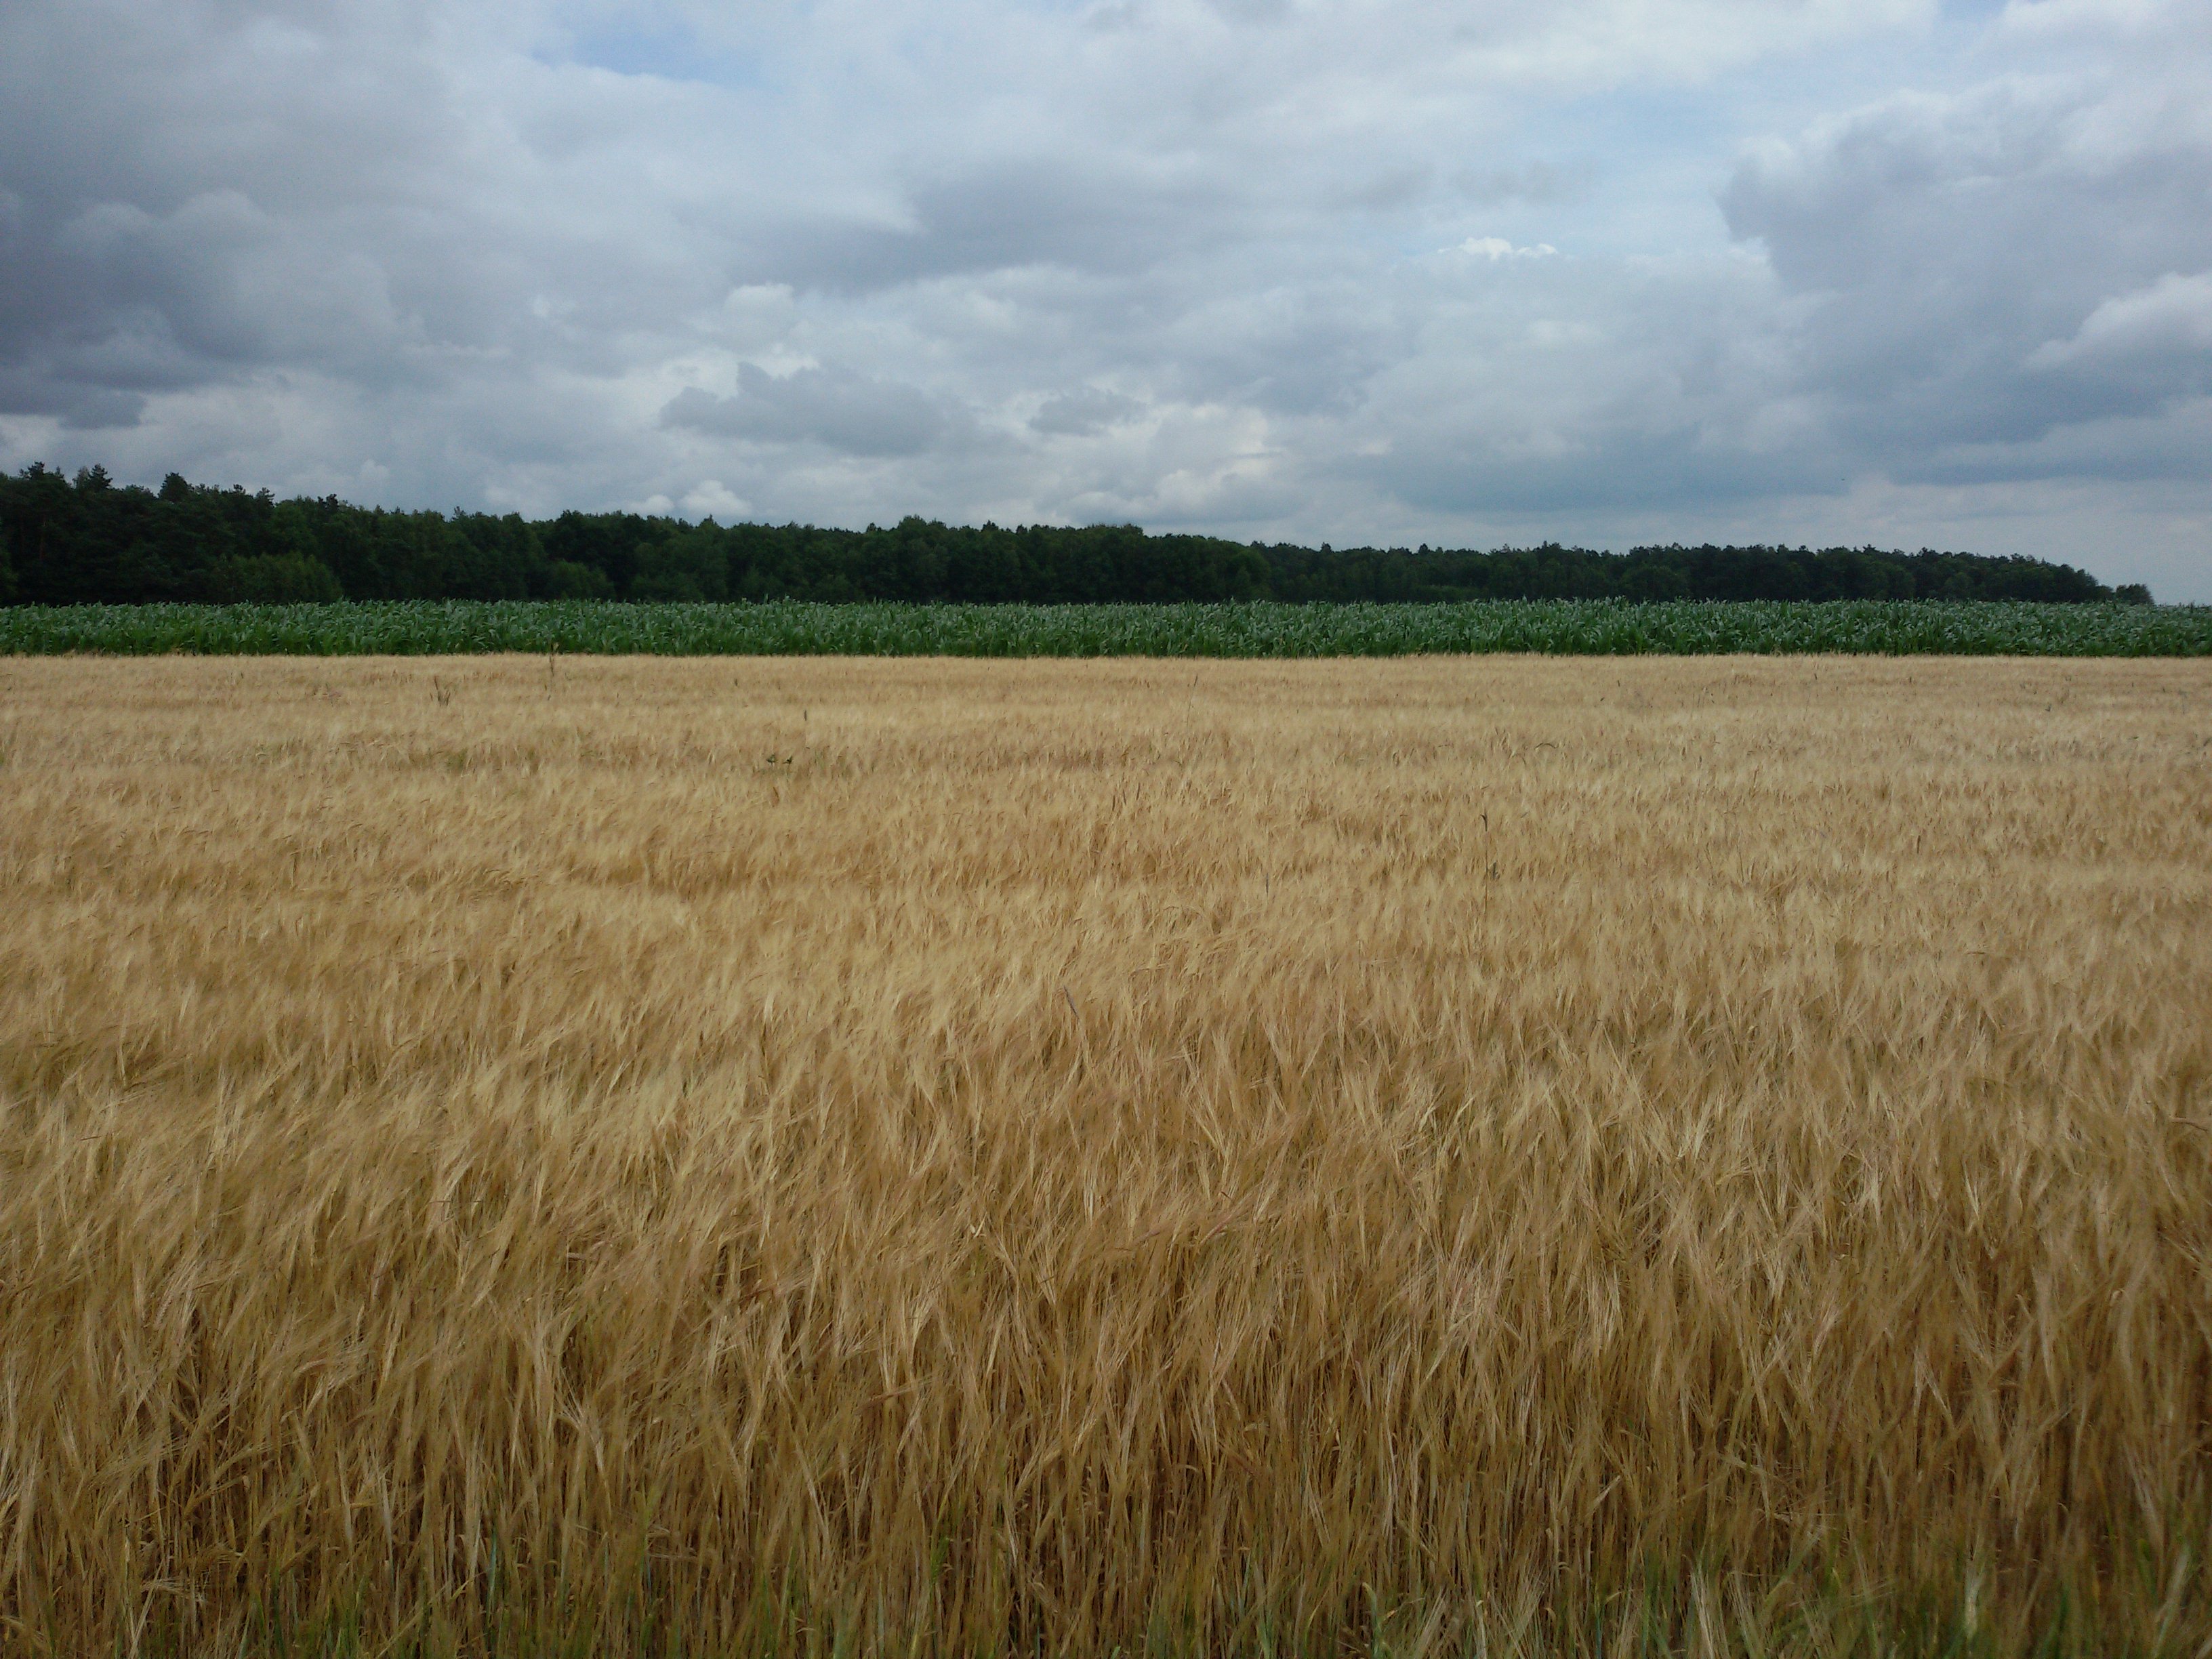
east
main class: Cropland
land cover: Maize
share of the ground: > 75 %
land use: Agriculture (excluding fallow land and kitchen gardens)
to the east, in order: Maize; Grass margins; Barley; Maize; Tracks; Potatoes; Tracks; Dry pulses; Potatoes
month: July
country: PL
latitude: 51.7998
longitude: 22.8774
